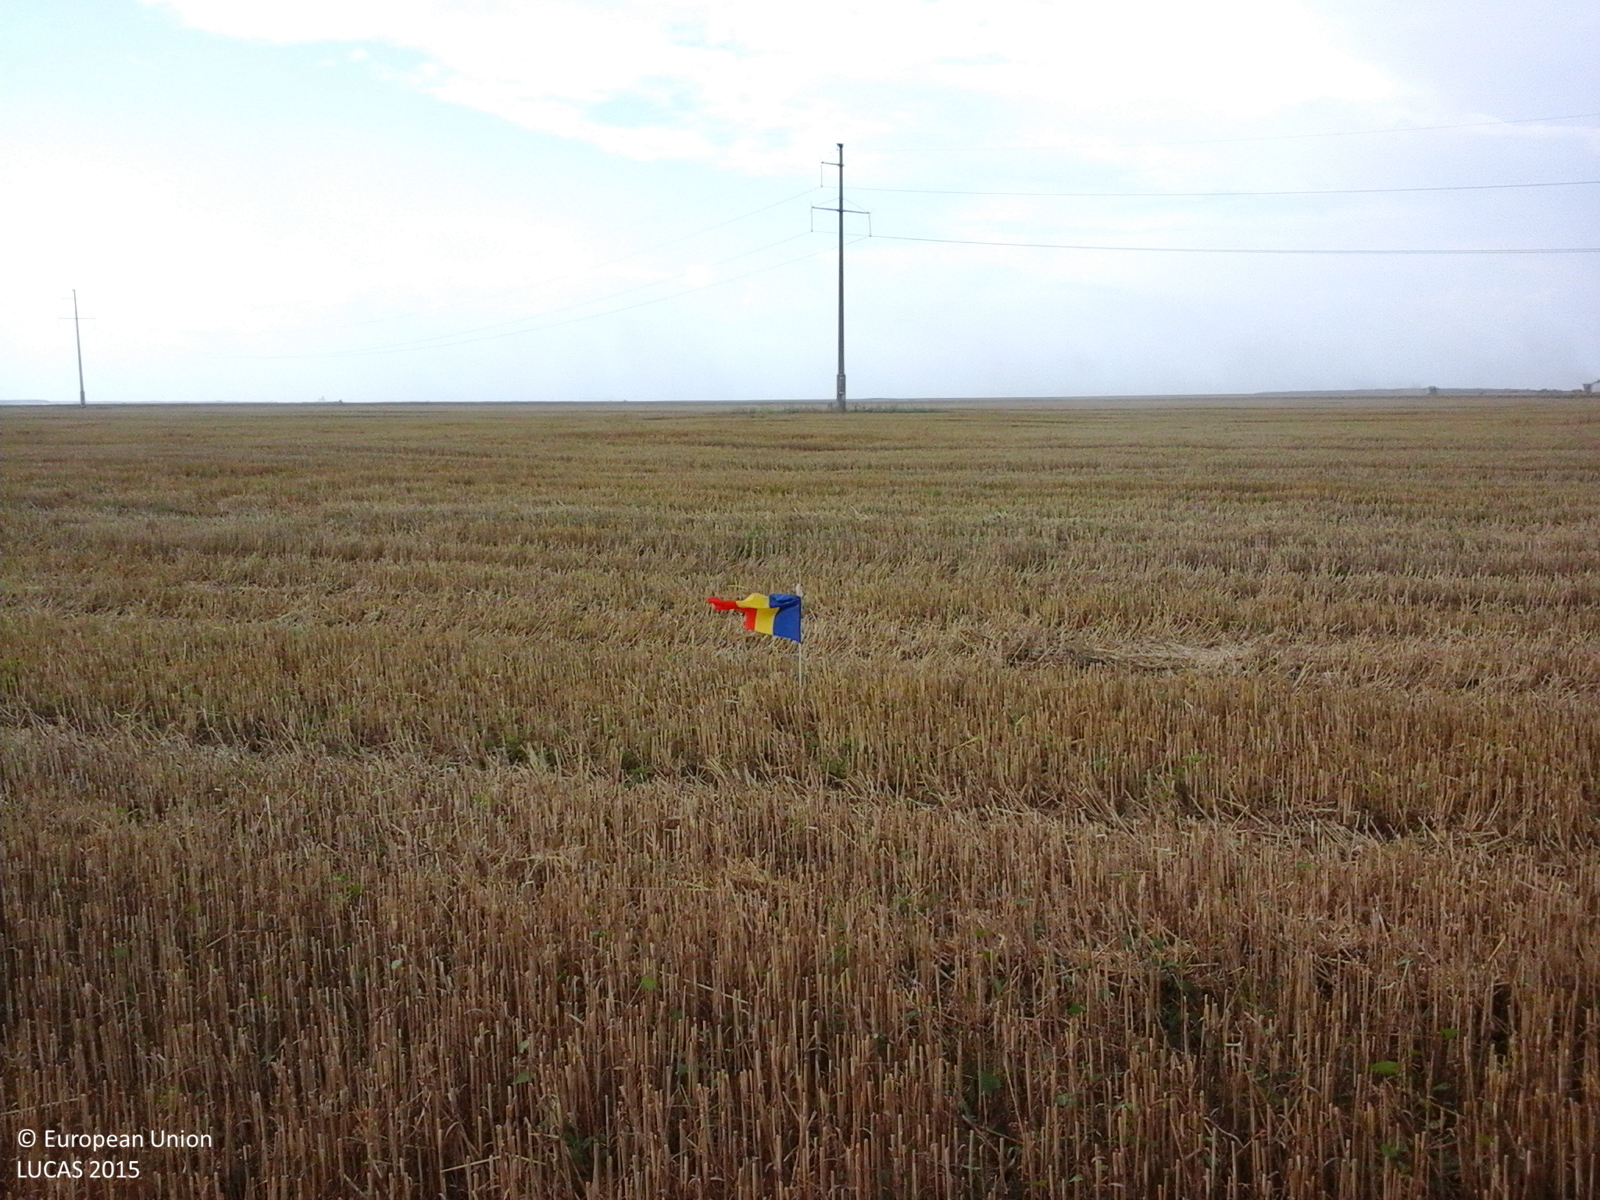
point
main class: Cropland
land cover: Common wheat
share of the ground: < 10 %
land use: Agriculture (excluding fallow land and kitchen gardens)
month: July
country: RO
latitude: 43.8941
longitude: 24.4934
